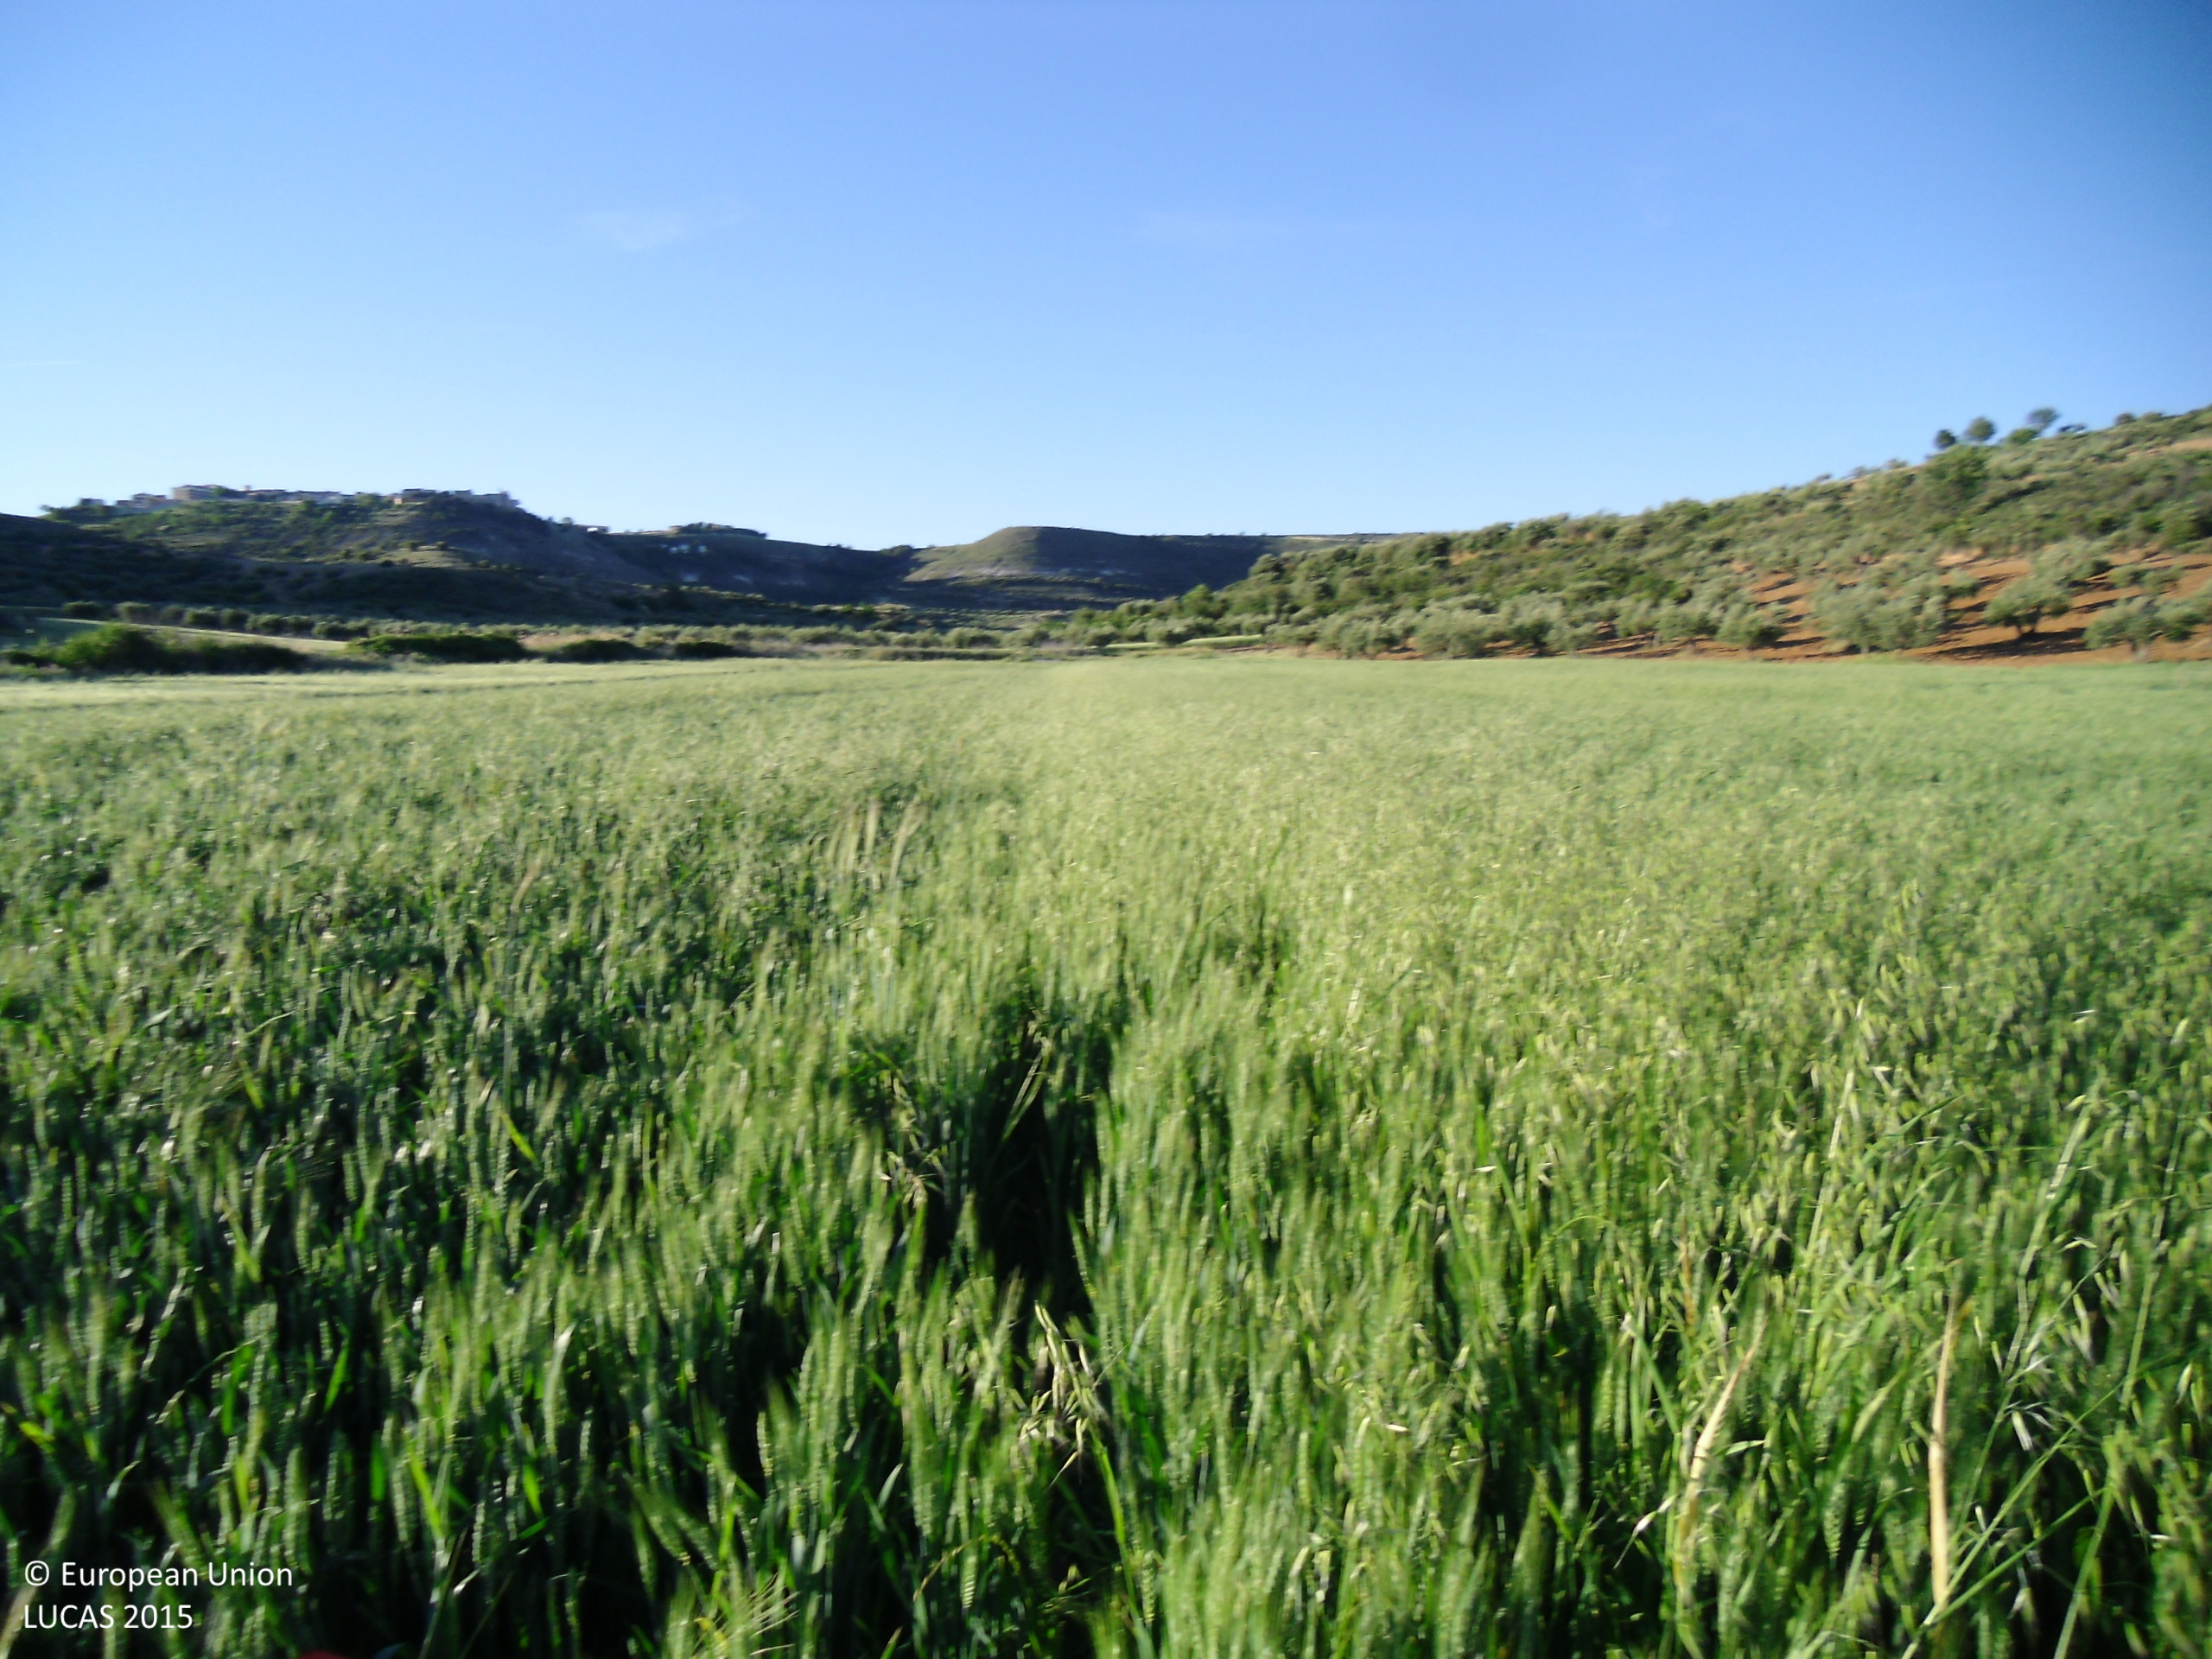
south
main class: Cropland
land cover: Triticale
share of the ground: > 75 %
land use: Agriculture (excluding fallow land and kitchen gardens)
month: May
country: ES
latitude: 40.7874
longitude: -3.0097
